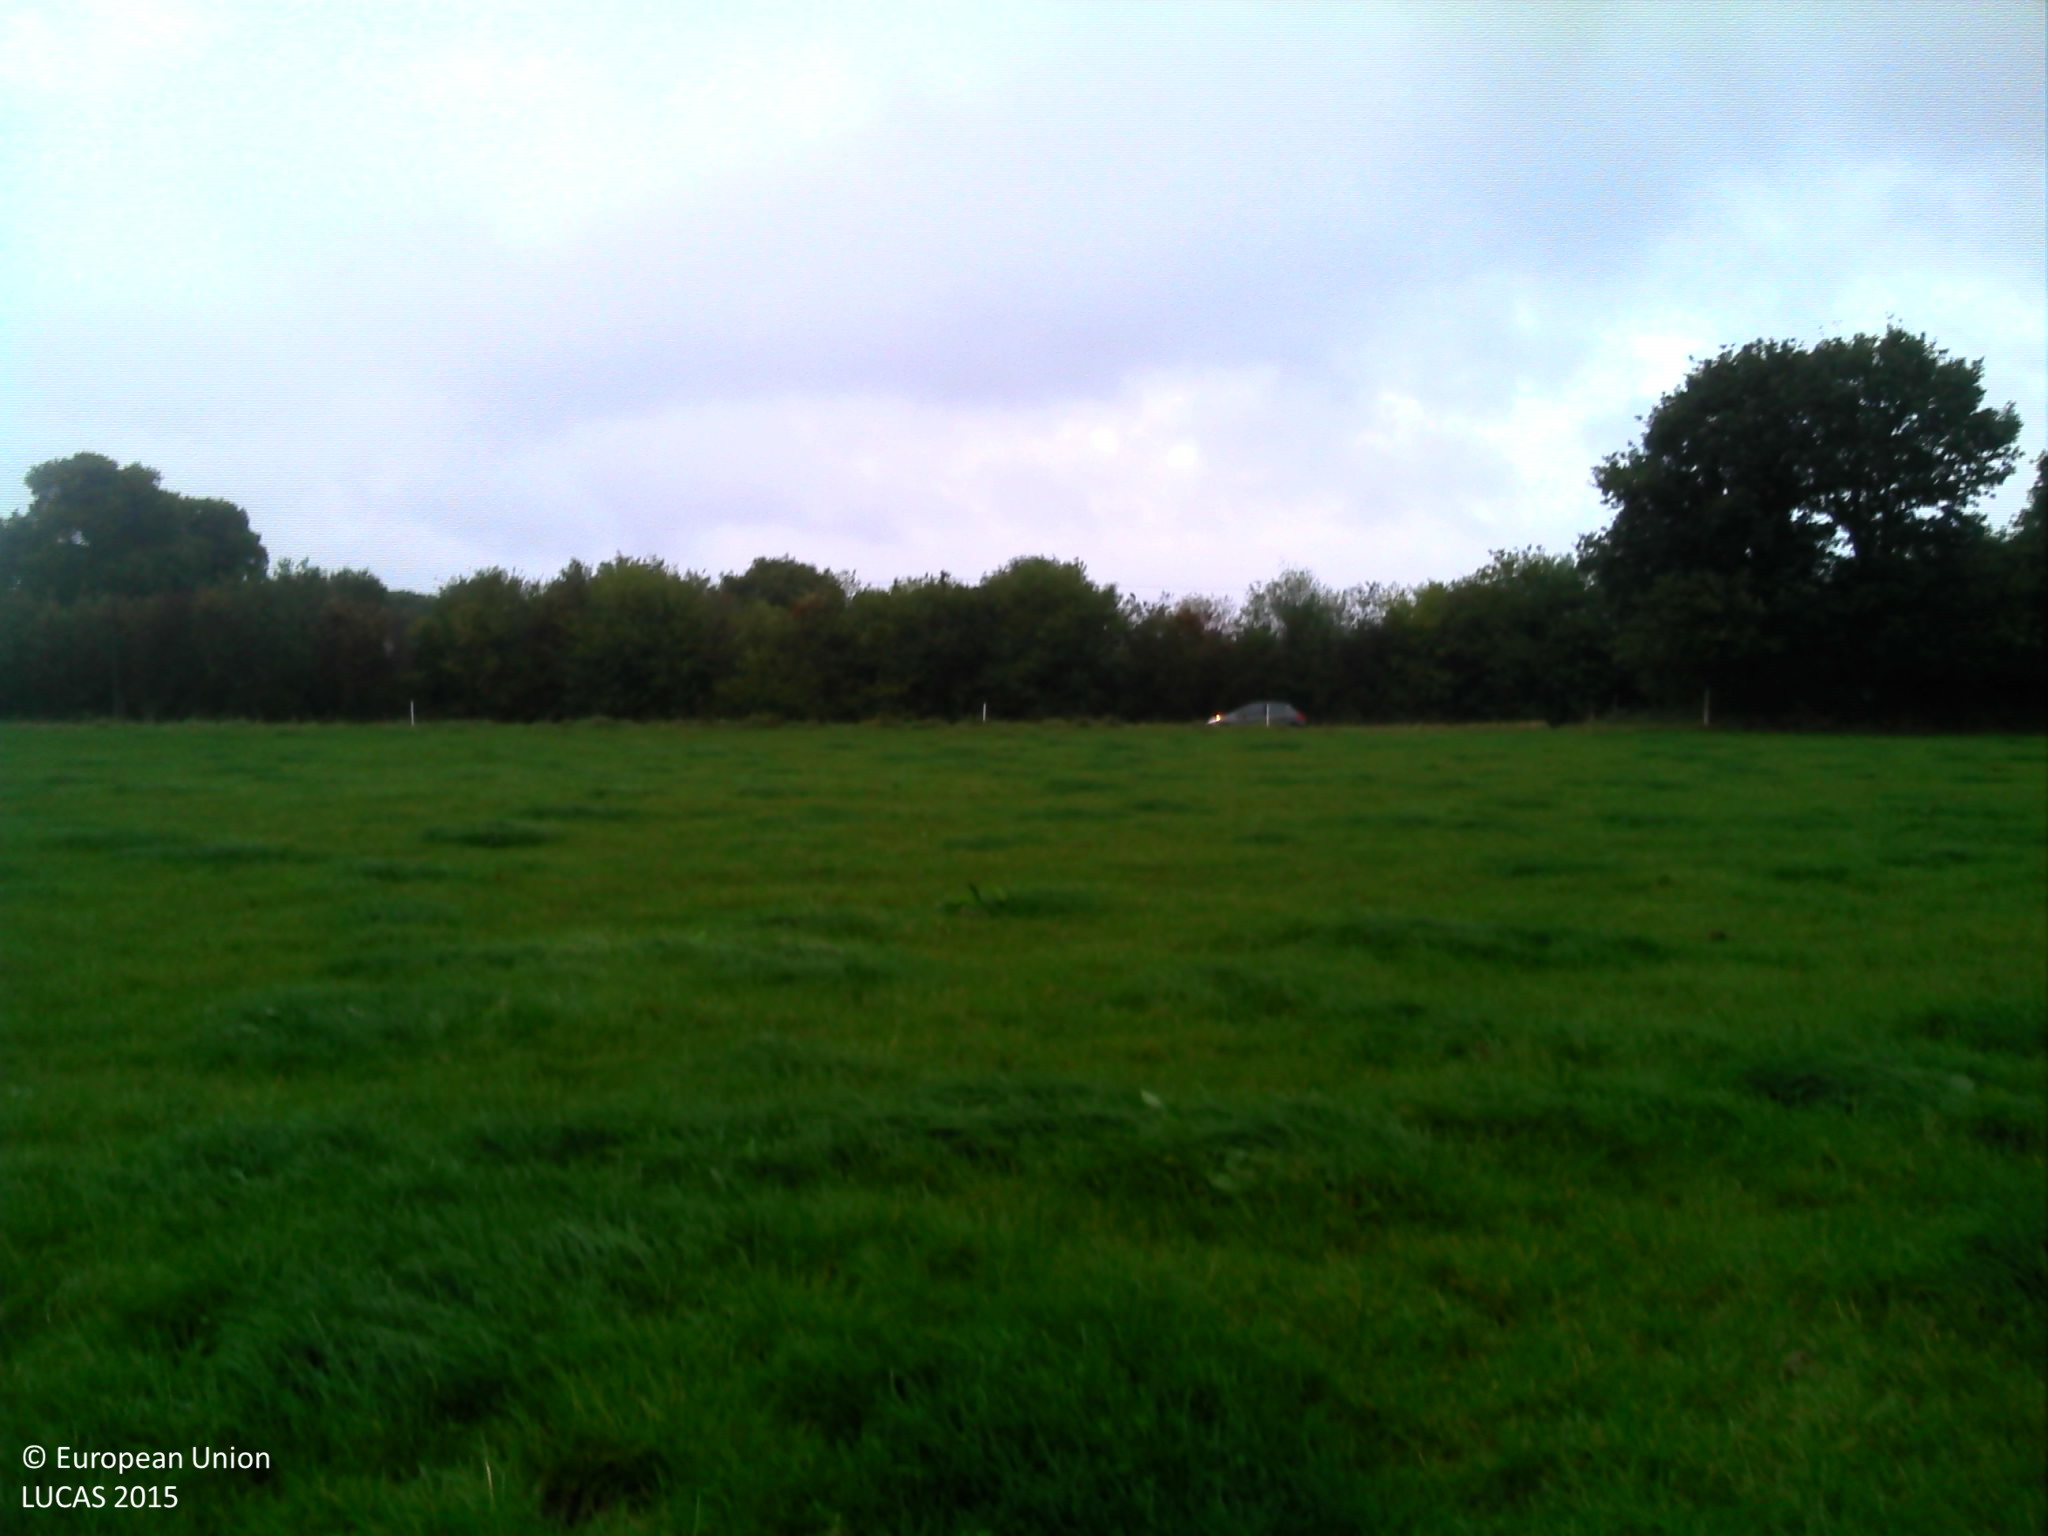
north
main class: Grassland
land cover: Grassland without tree/shrub cover
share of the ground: > 75 %
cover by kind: herbaceous plants 100 %
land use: Agriculture (excluding fallow land and kitchen gardens)
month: August
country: FR
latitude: 48.3290
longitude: -3.4167
